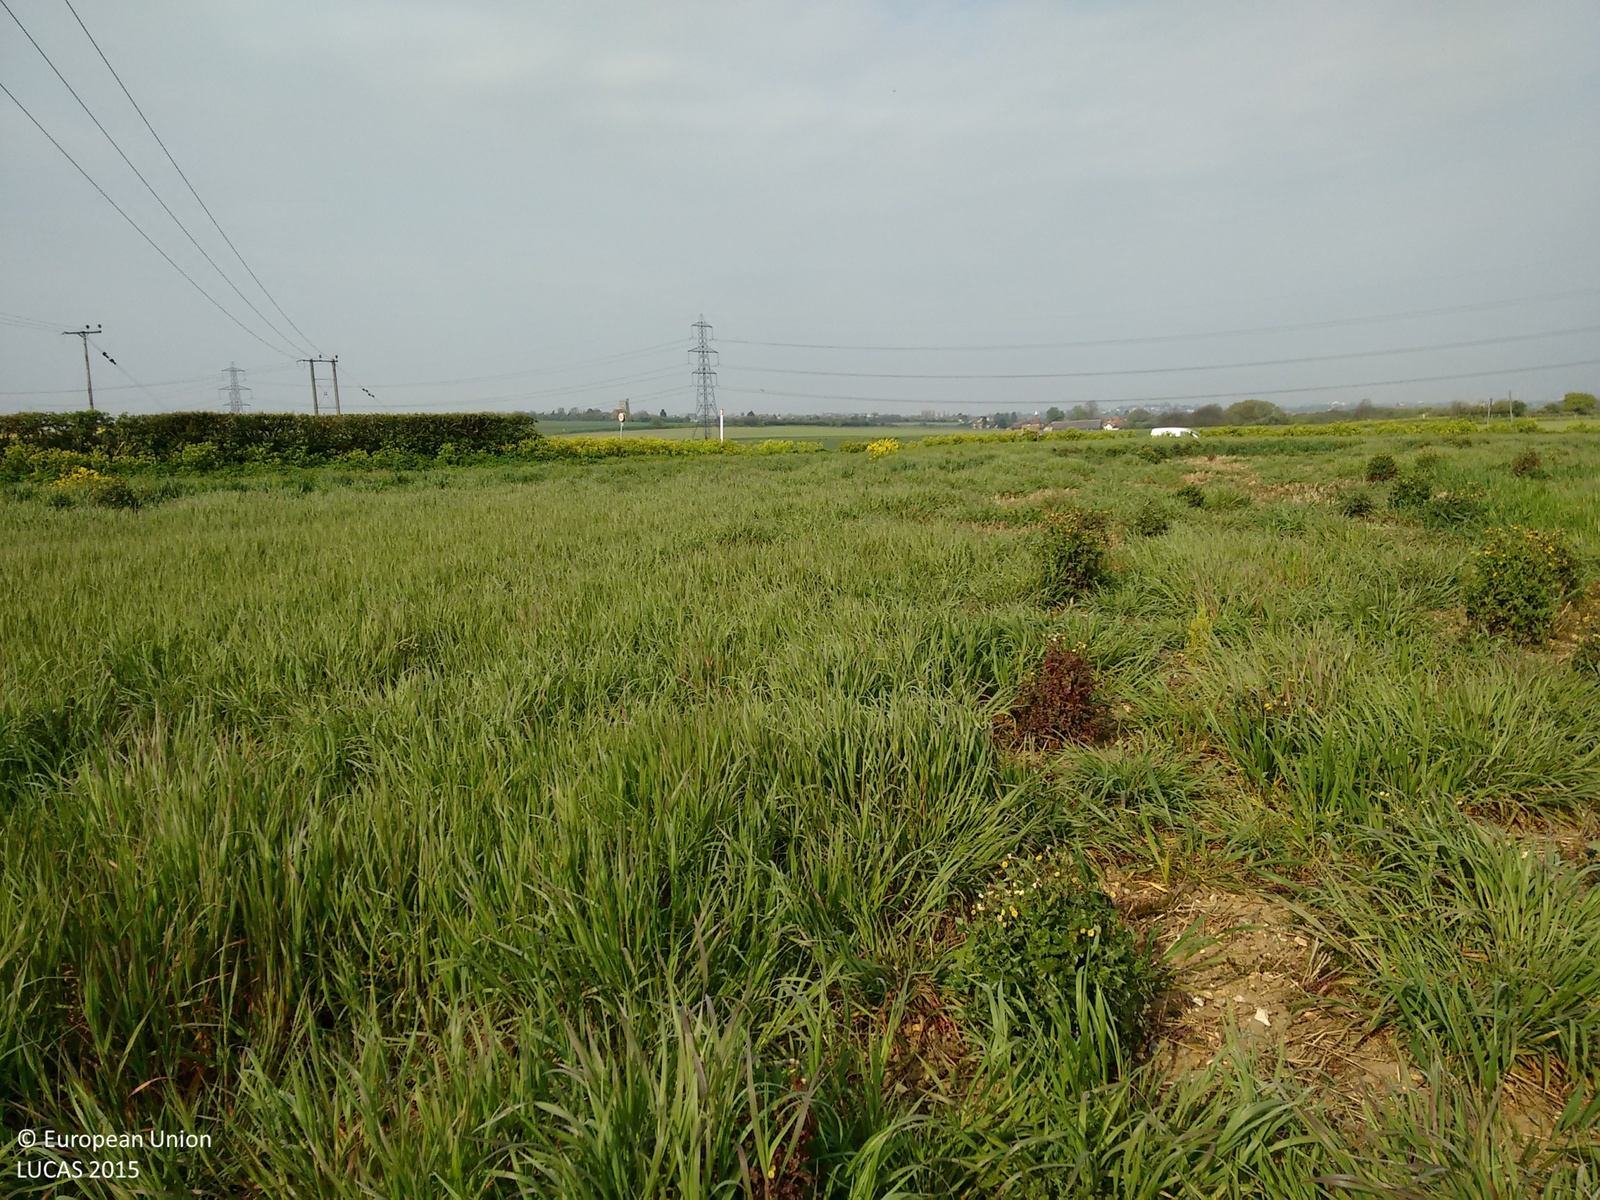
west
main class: Grassland
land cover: Spontaneously vegetated surfaces
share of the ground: 50 - 75 %
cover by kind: herbaceous plants 50 %, unconsolidated bare surface 50 %
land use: Fallow land
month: April
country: GB
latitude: 51.4292
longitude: 0.4355
